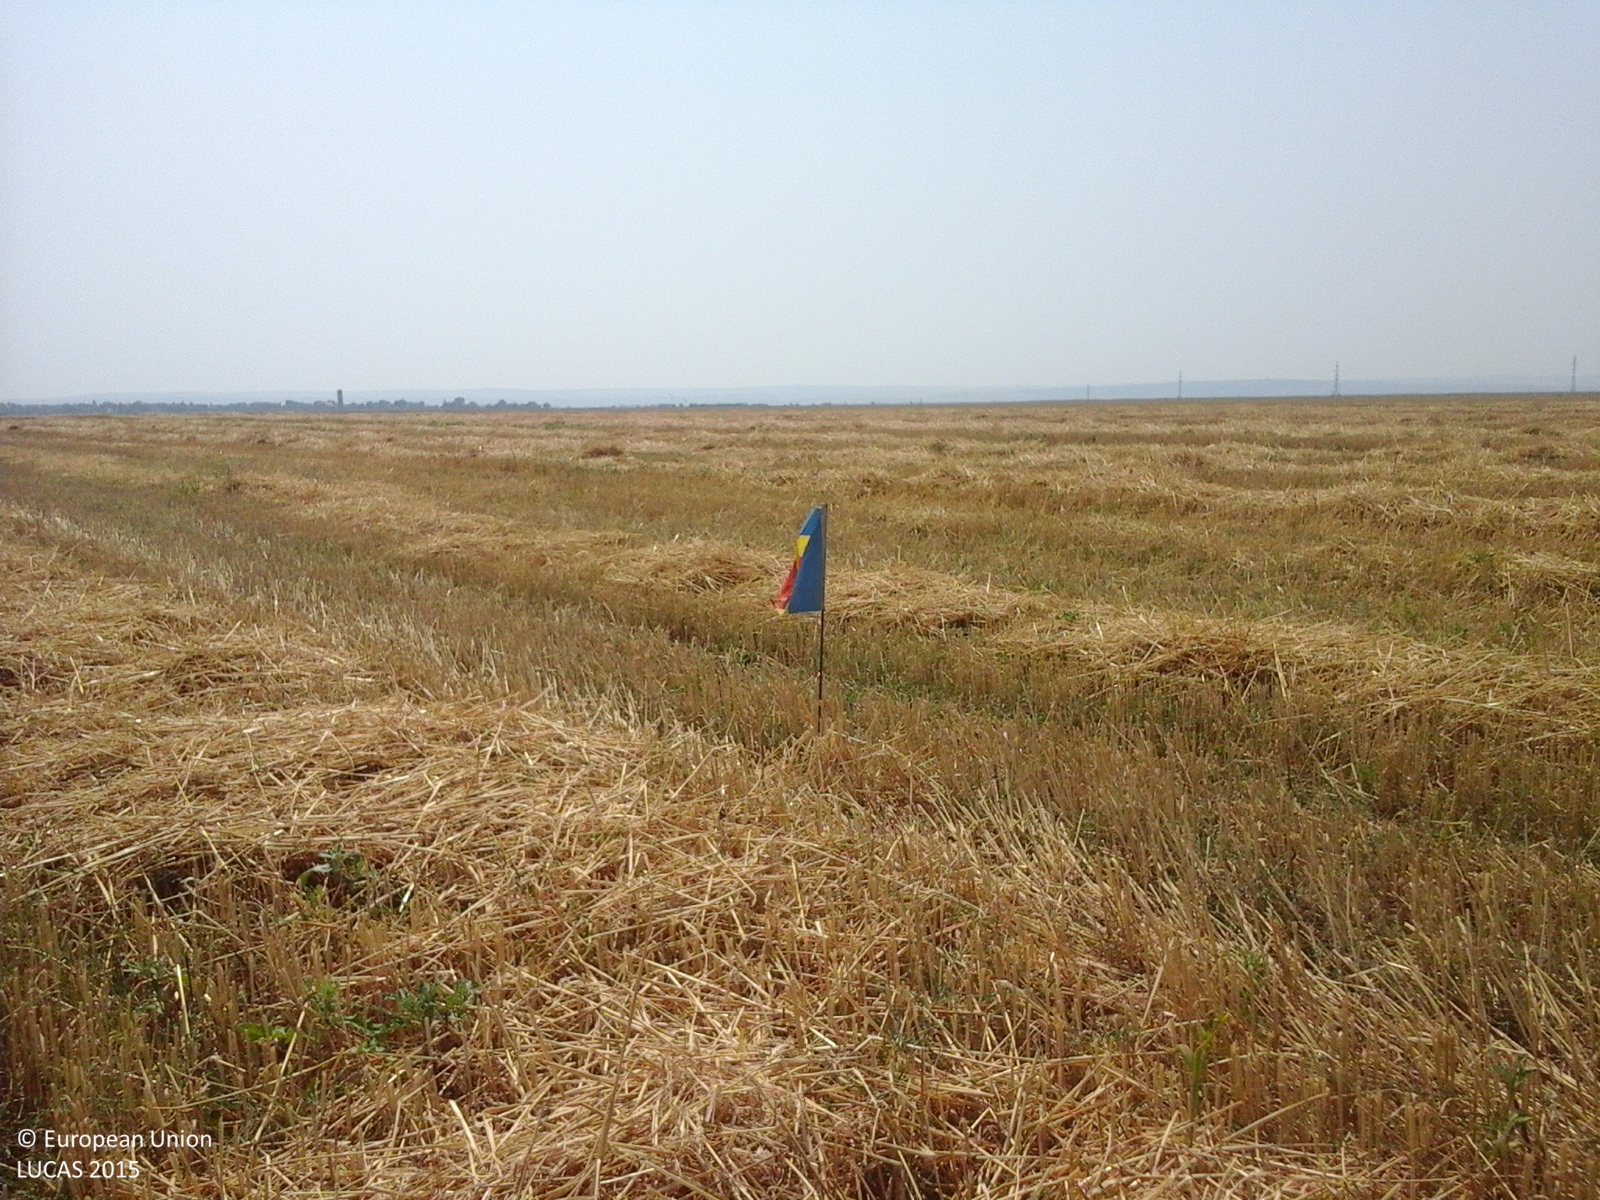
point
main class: Cropland
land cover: Common wheat
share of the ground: > 75 %
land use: Agriculture (excluding fallow land and kitchen gardens)
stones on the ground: < 10 %
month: August
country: RO
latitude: 44.2356
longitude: 22.7481
